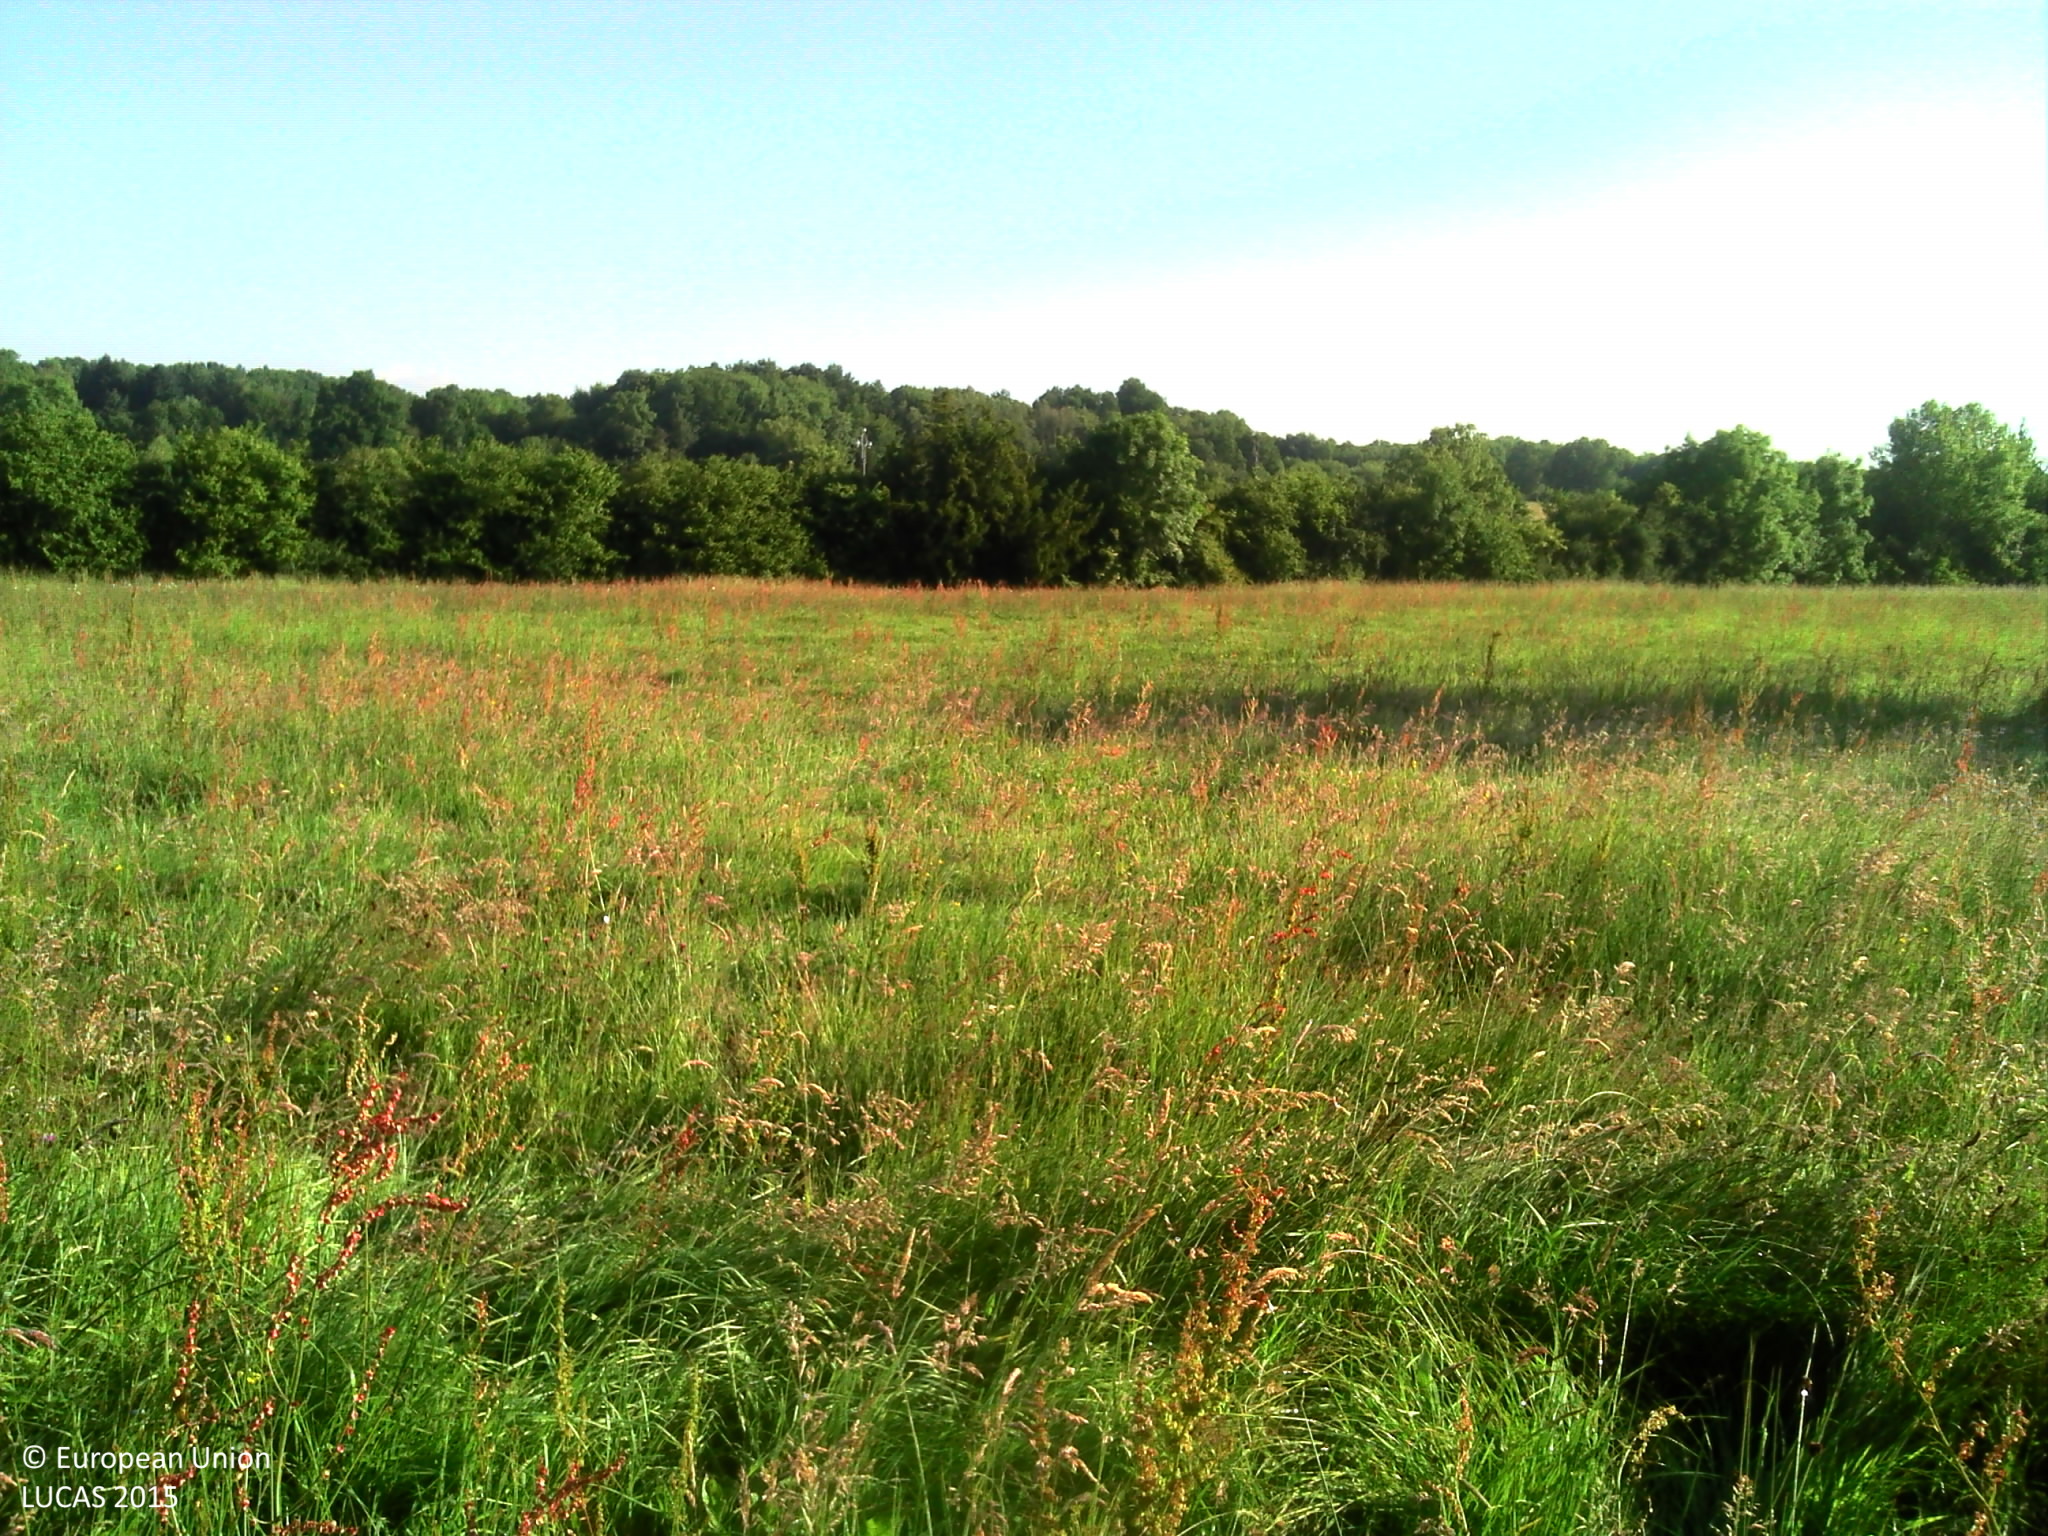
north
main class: Grassland
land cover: Grassland without tree/shrub cover
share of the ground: > 75 %
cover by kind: herbaceous plants 100 %
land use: Agriculture (excluding fallow land and kitchen gardens)
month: June
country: FR
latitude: 49.1056
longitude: 0.3705
